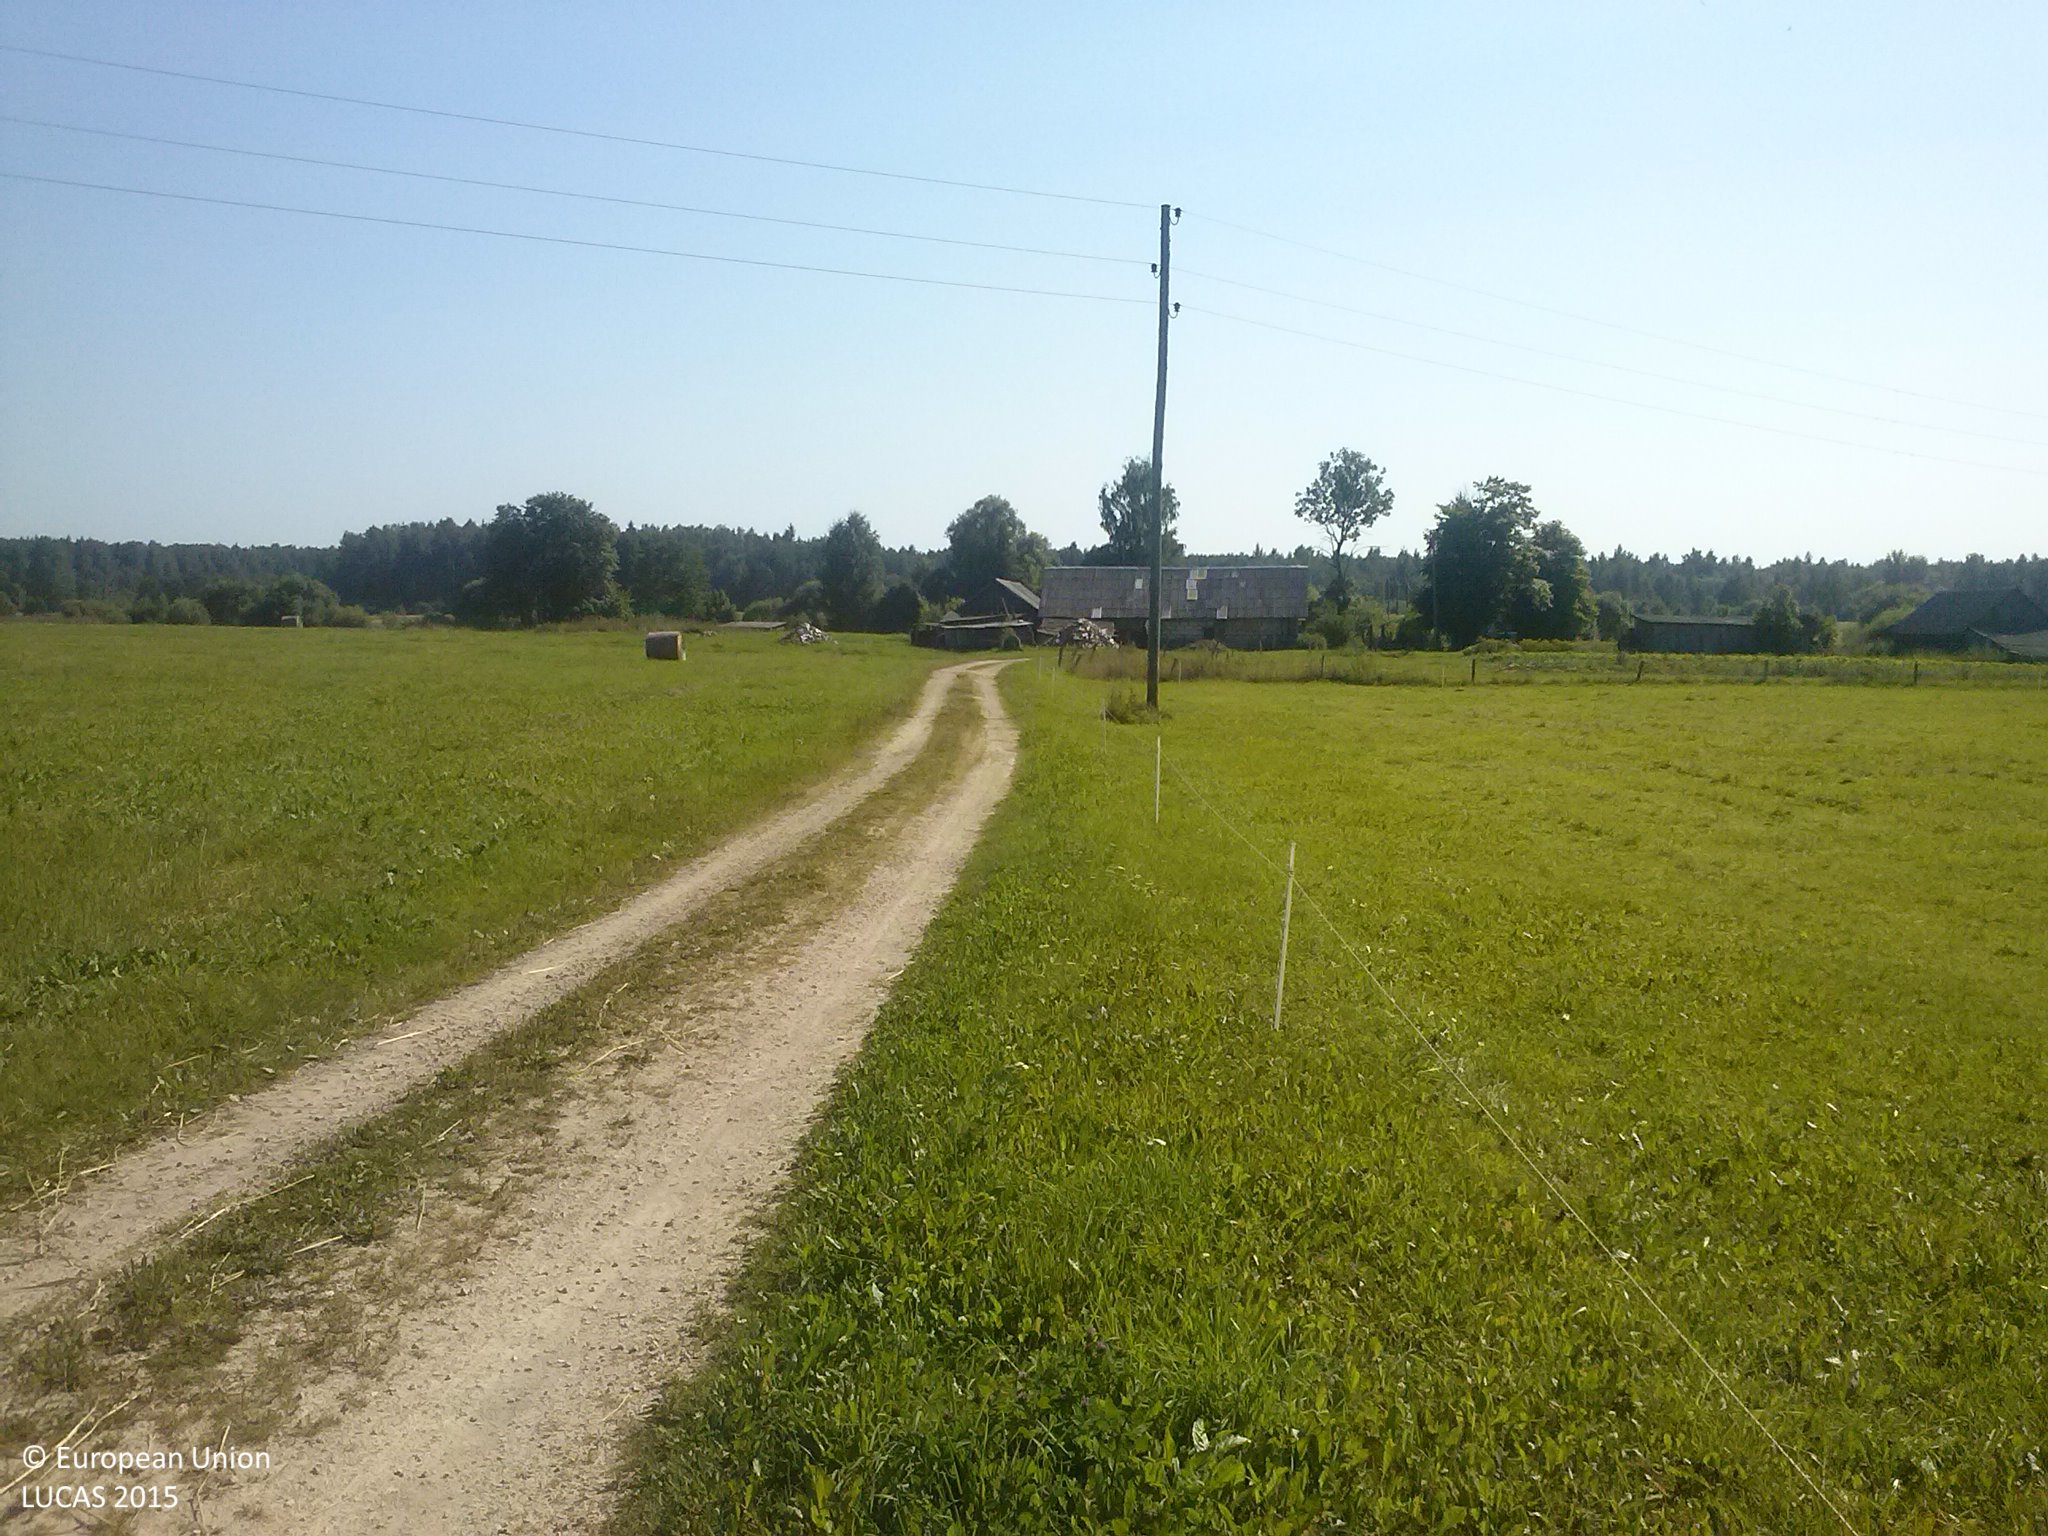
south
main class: Grassland
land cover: Grassland without tree/shrub cover
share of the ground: > 75 %
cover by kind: herbaceous plants 100 %
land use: Agriculture (excluding fallow land and kitchen gardens)
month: August
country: LV
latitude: 56.6868
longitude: 27.7703
